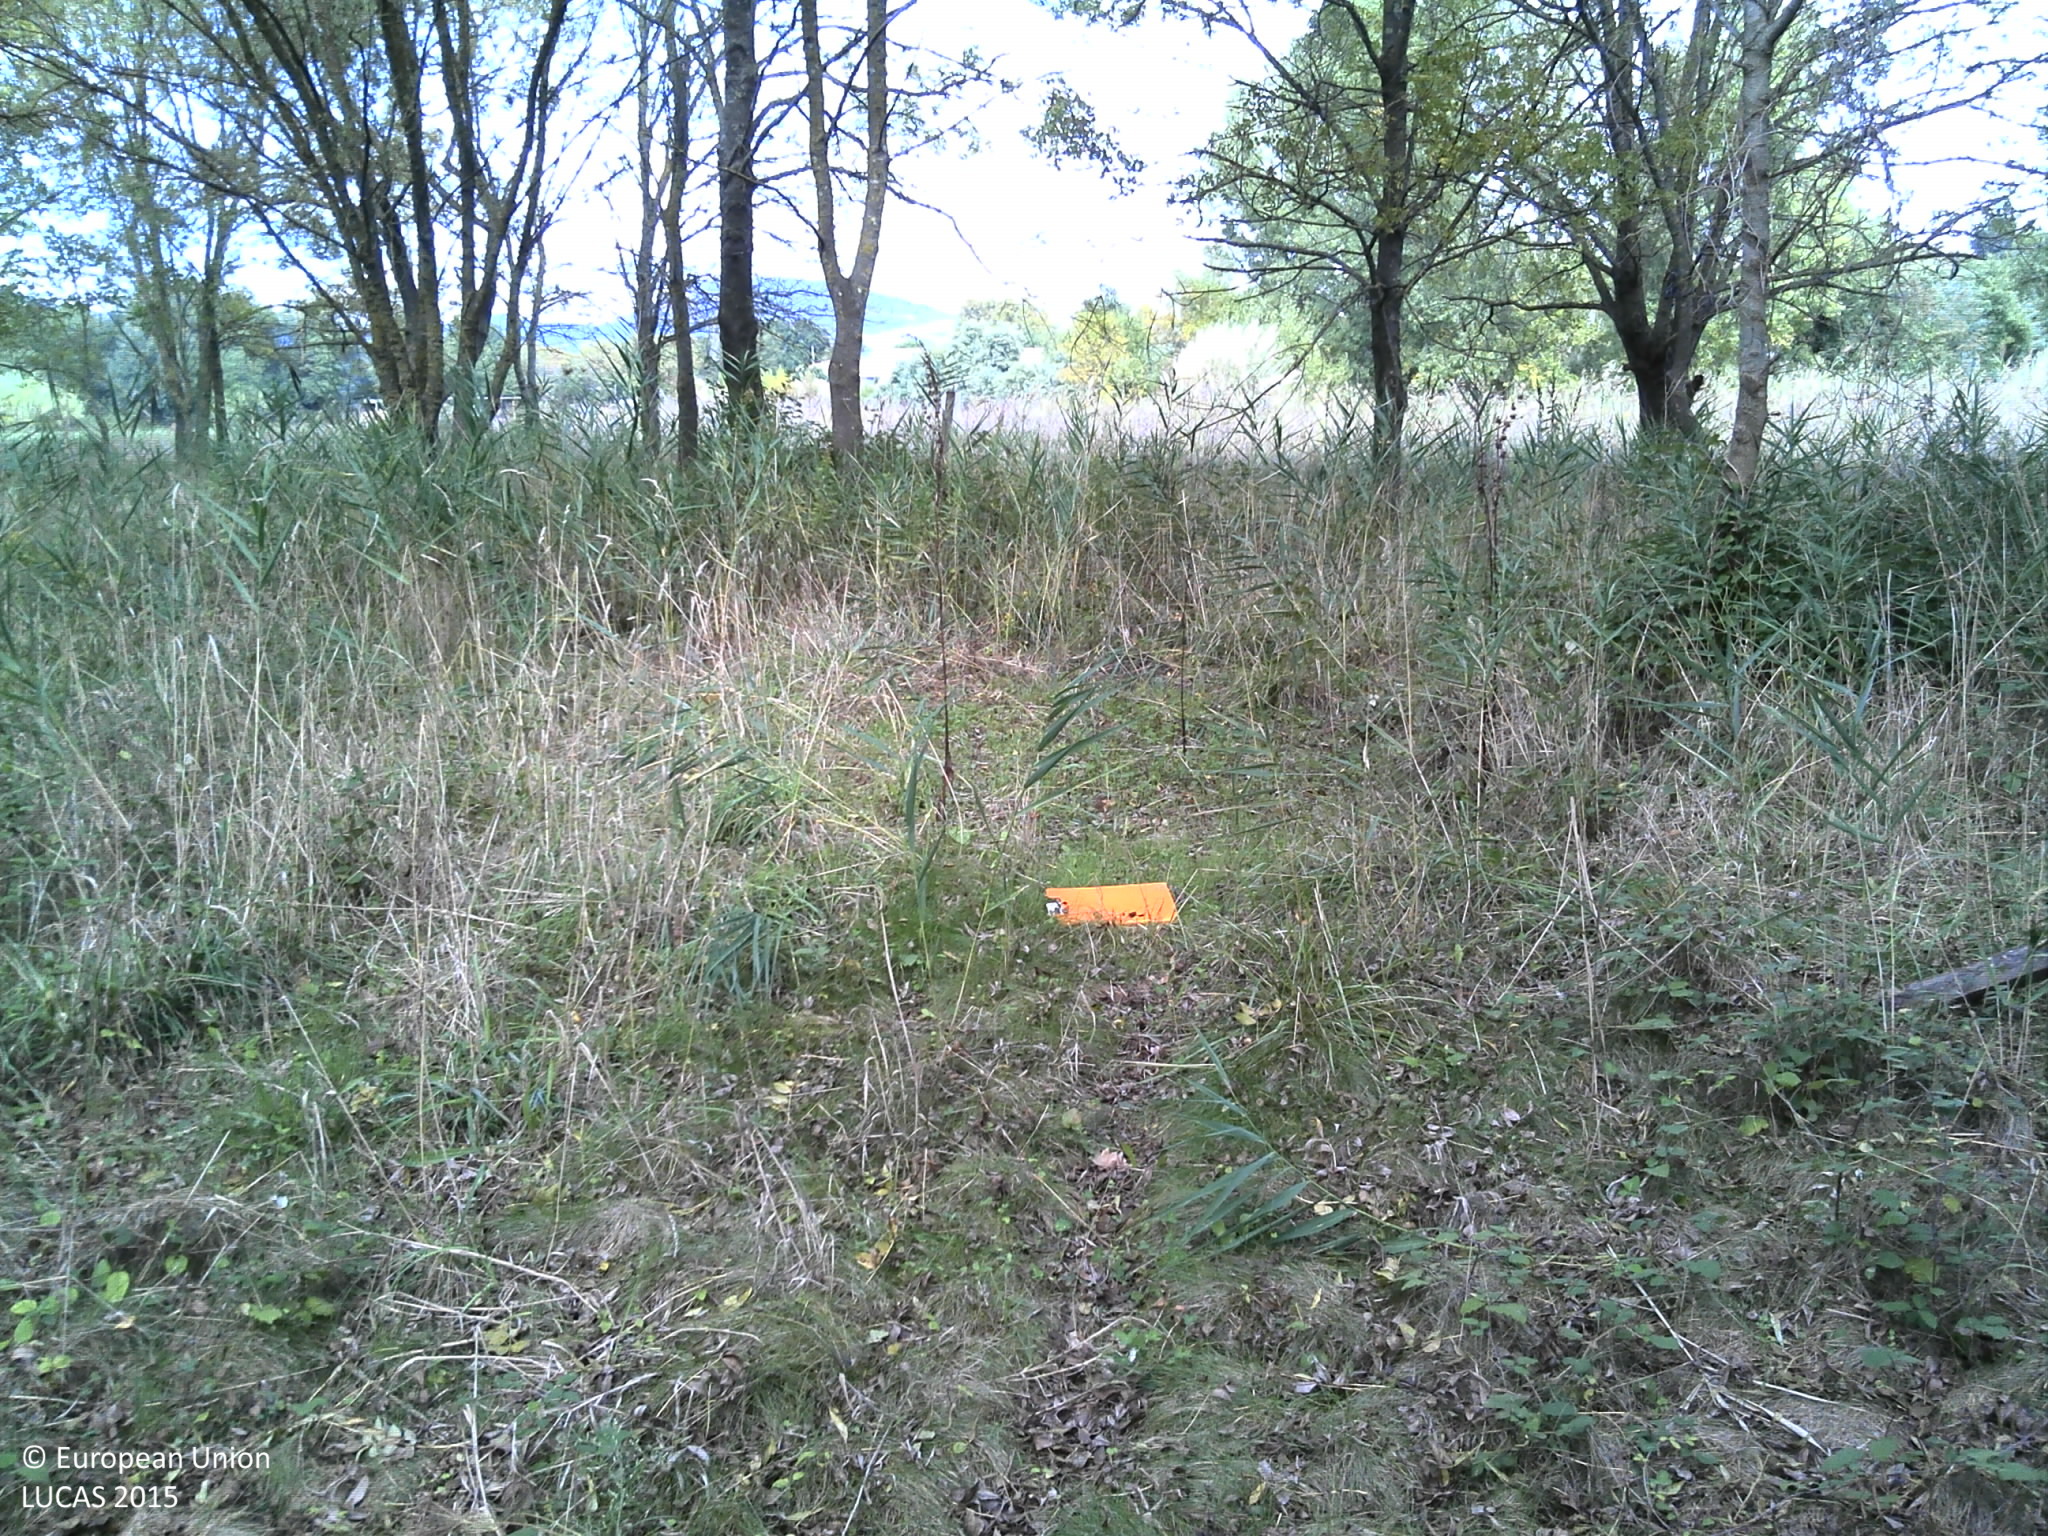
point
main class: Woodland
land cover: Broadleaved woodland
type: thermophilous deciduous forest
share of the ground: > 75 %
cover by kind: broadleaved forest trees 70 %, herbaceous plants 20 %, unconsolidated bare surface 10 %
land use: Abandoned areas
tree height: > 5 m
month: October
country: FR
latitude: 43.2646
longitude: 6.5717
